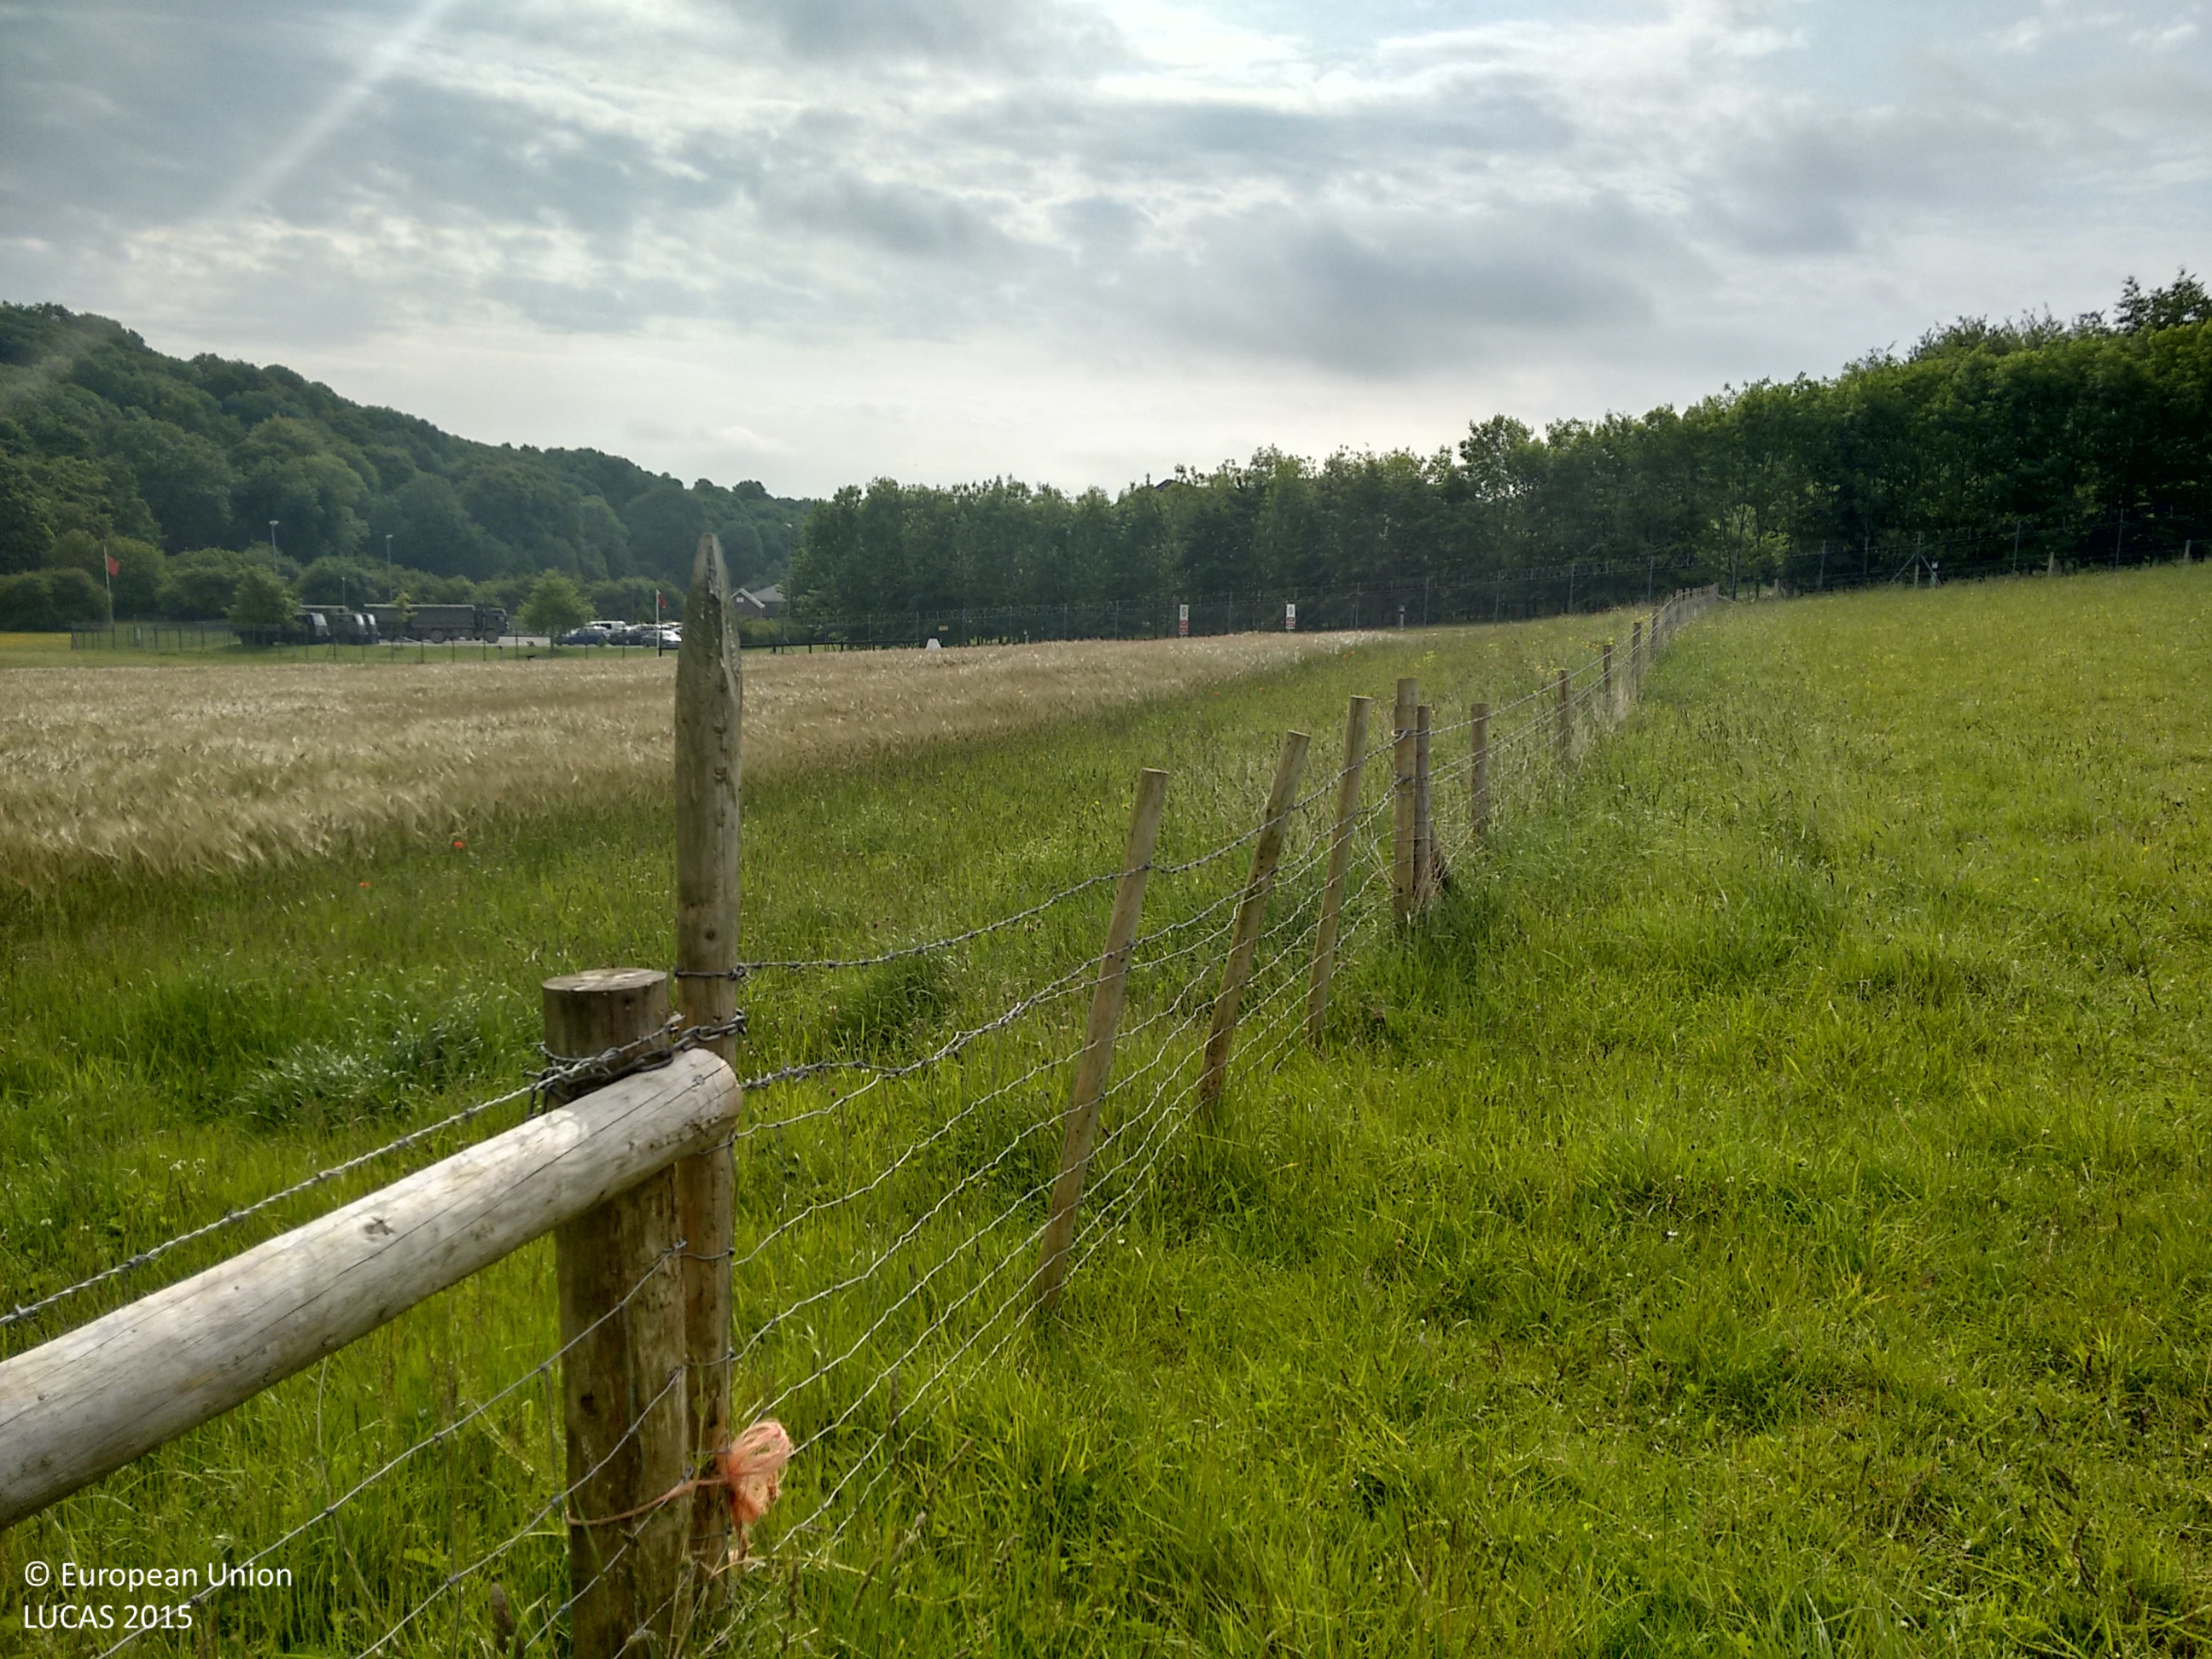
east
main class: Cropland
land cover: Barley
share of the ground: > 75 %
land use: Agriculture (excluding fallow land and kitchen gardens)
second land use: Community services
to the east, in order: Barley; Grassland without tree/shrub cover; Paved roads, cycling and walking lanes; Grassland with sparse tree/shrub cover; Broadleaved woodland
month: June
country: GB
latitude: 51.2220
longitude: -2.1599
